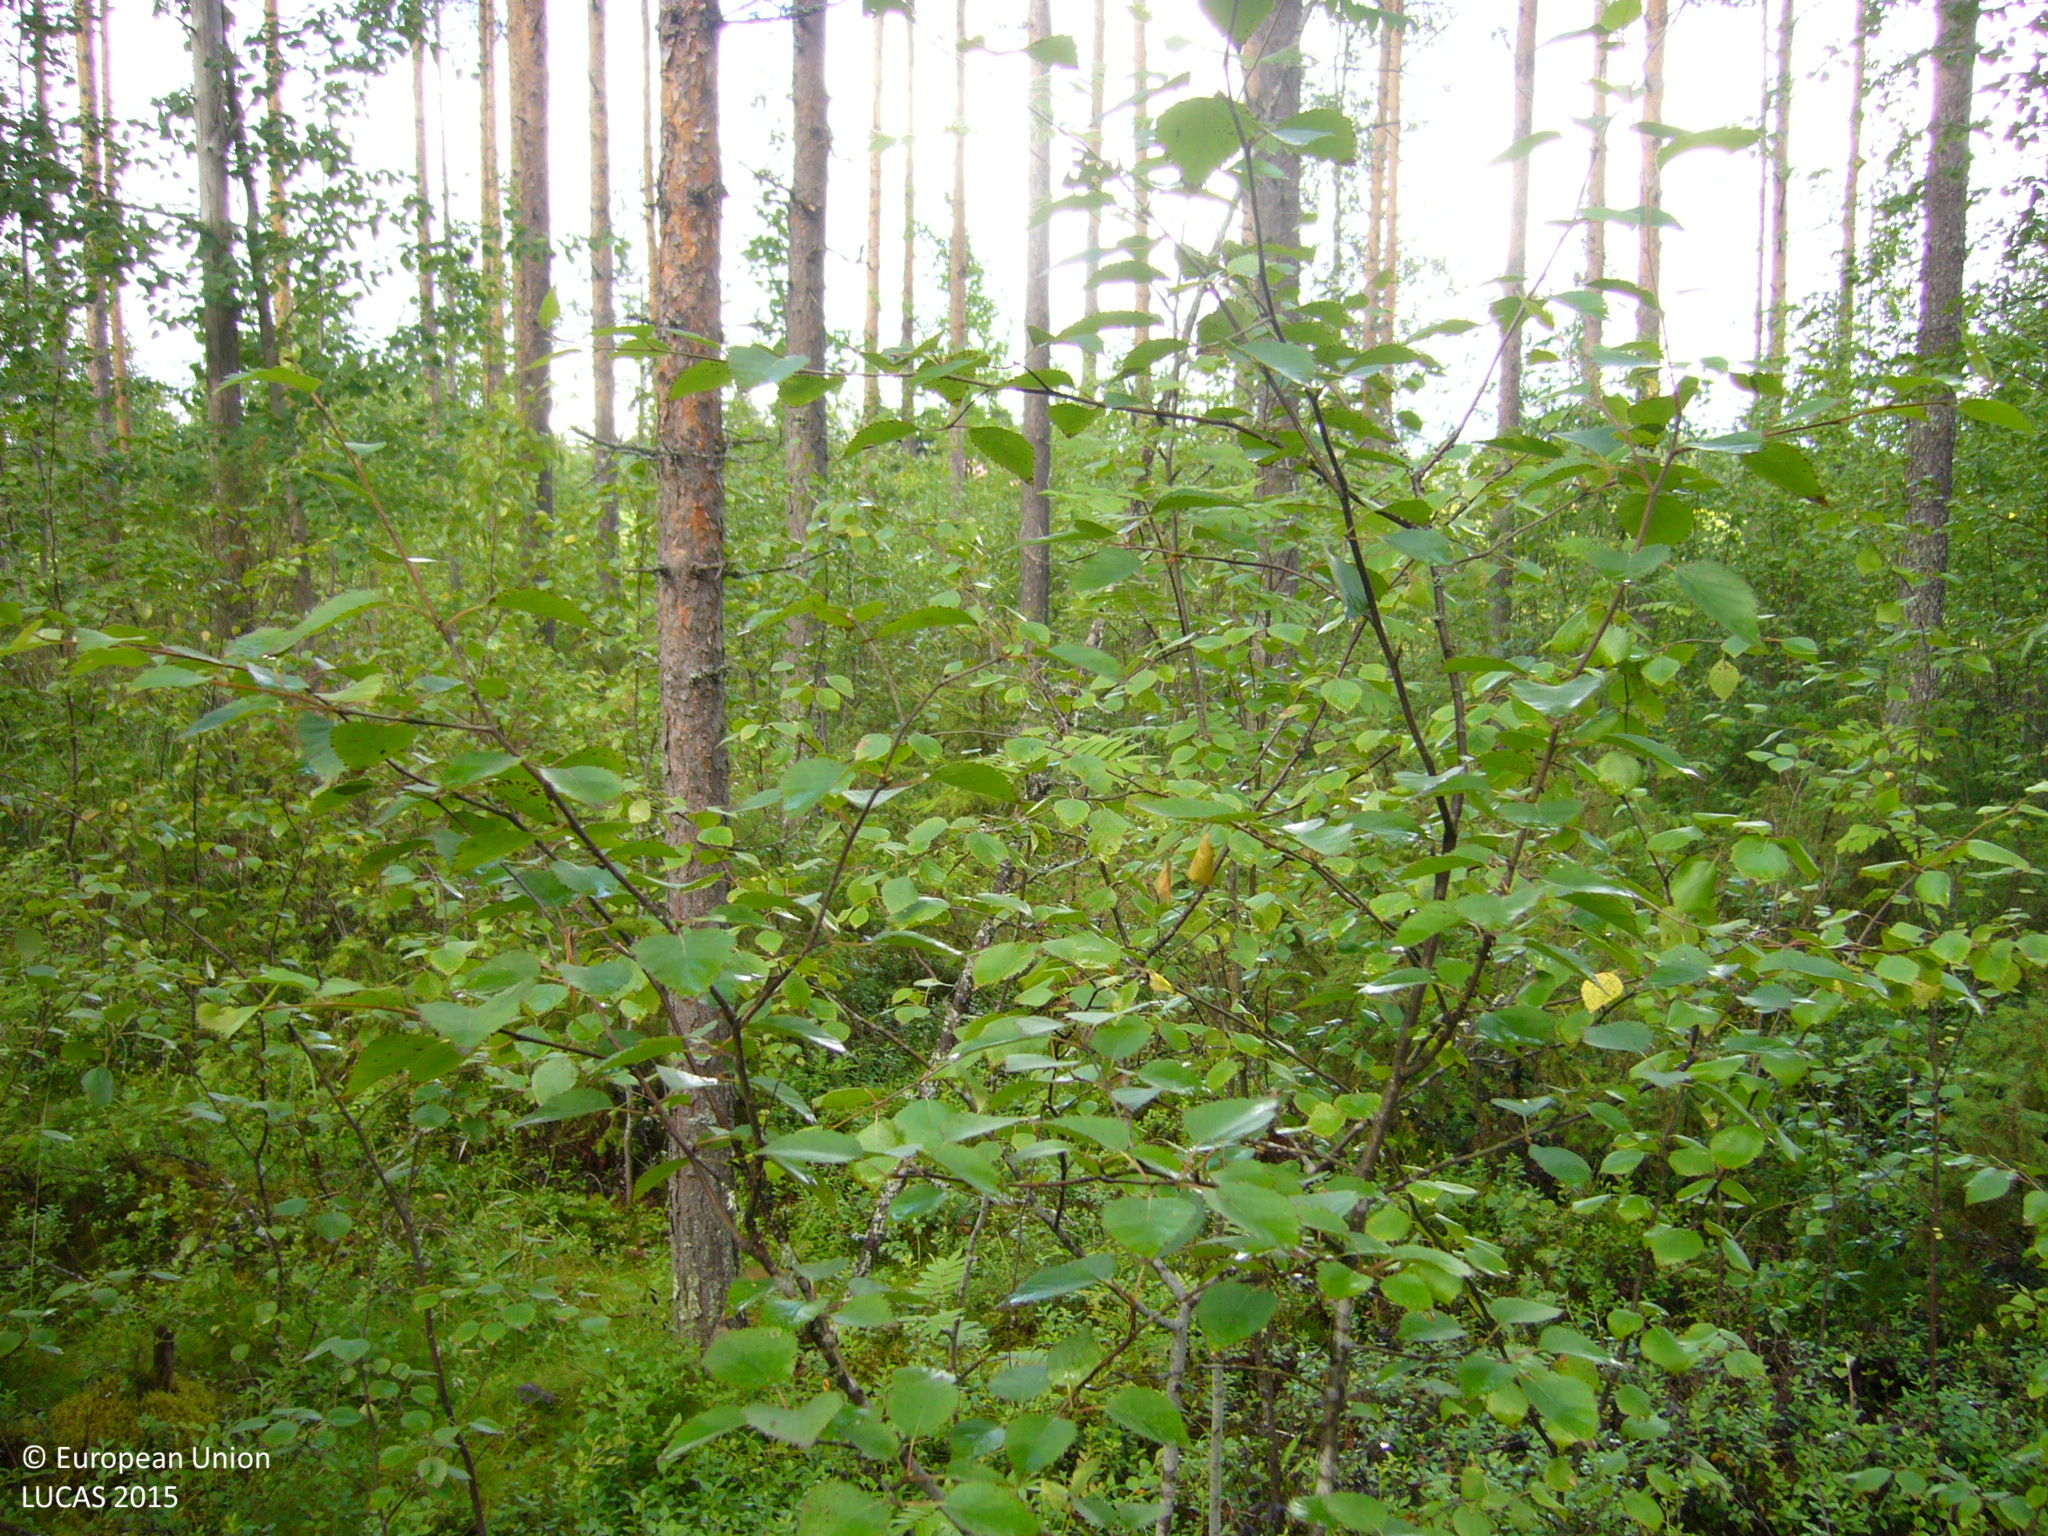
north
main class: Woodland
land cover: Pine dominated mixed woodland
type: boreal forest
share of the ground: > 75 %
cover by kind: coniferous forest trees 50 %, broadleaved forest trees 30 %, shrubs 20 %
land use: Forestry
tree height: > 5 m
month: July
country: FI
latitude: 63.9723
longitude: 25.7689
